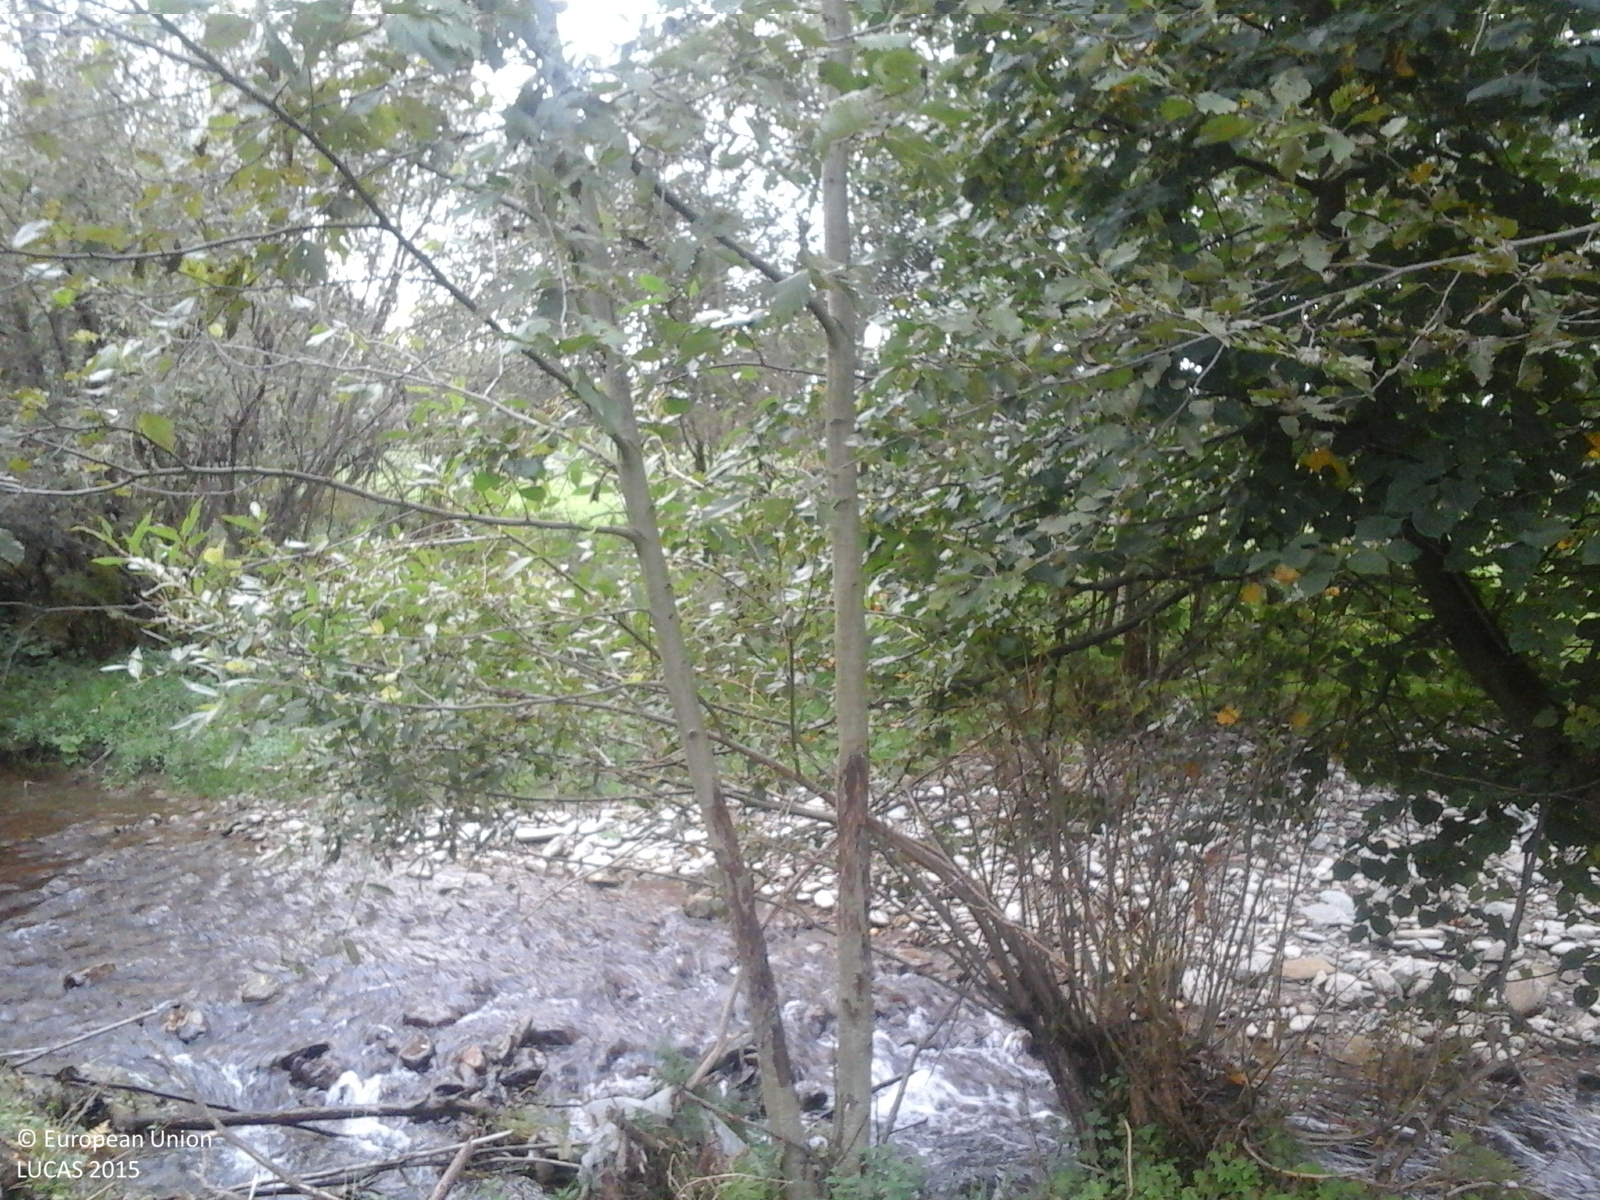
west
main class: Woodland
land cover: Other mixed woodland
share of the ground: > 75 %
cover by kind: broadleaved forest trees 65 %, coniferous forest trees 25 %, herbaceous plants 10 %
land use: Forestry
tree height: < 5 m
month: October
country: RO
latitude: 45.7140
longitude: 24.8225
